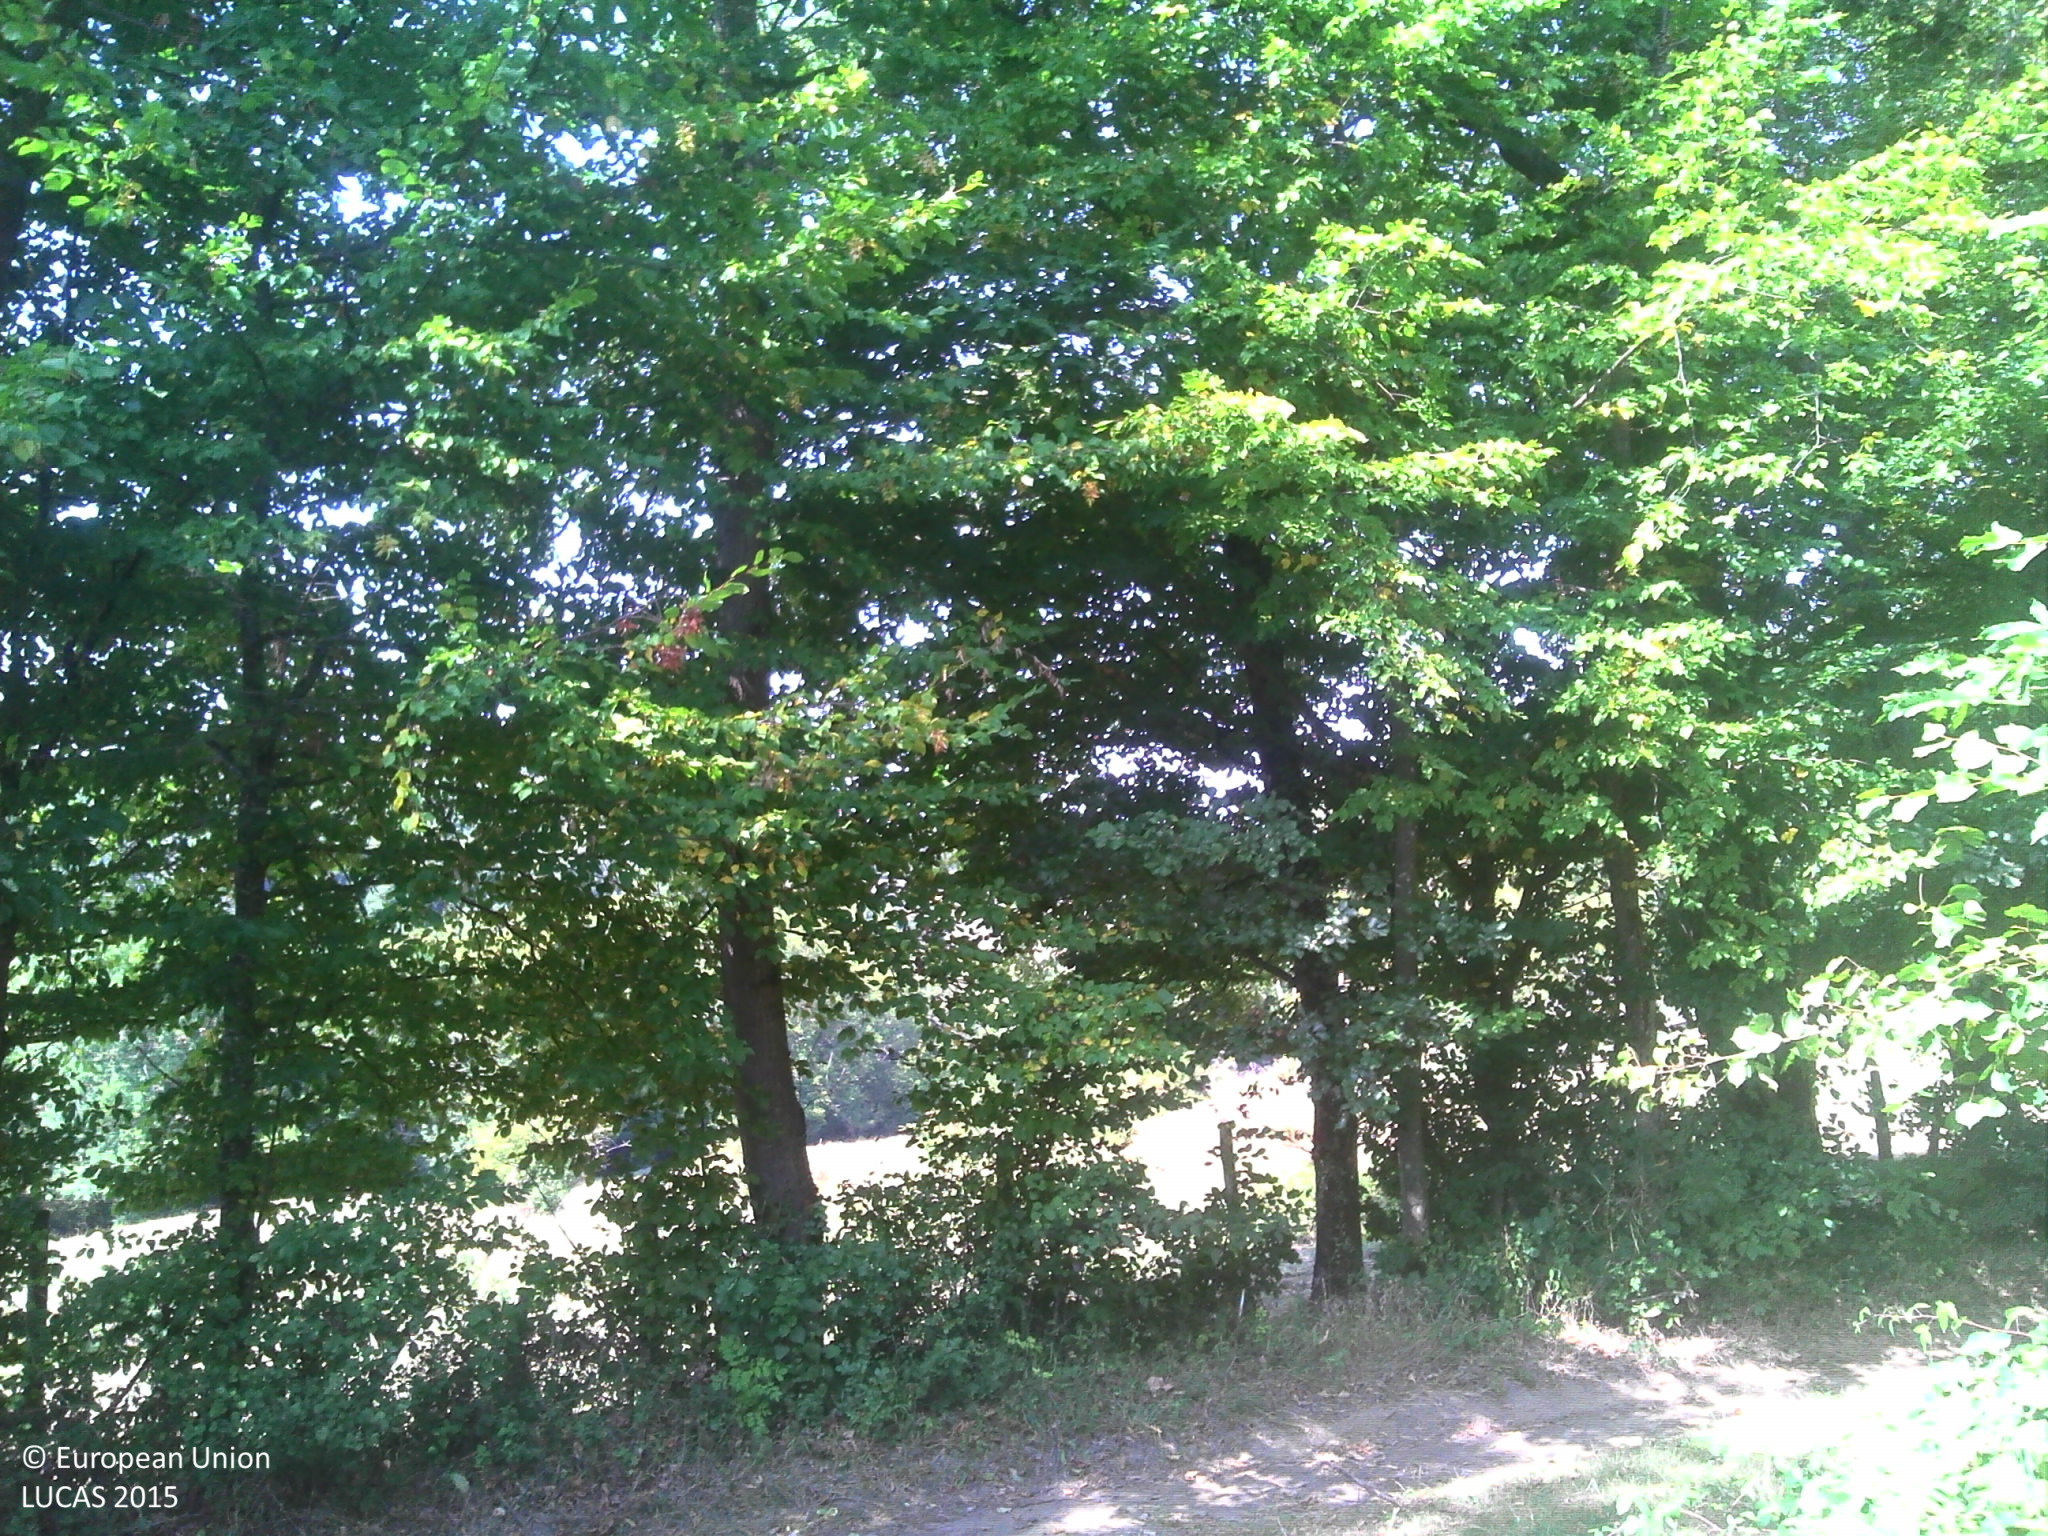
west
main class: Woodland
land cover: Broadleaved woodland
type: thermophilous deciduous forest
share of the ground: > 75 %
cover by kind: broadleaved forest trees 90 %, coniferous forest trees 5 %, herbaceous plants 5 %
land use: Forestry
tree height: > 5 m
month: September
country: FR
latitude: 45.2450
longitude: 5.0745
